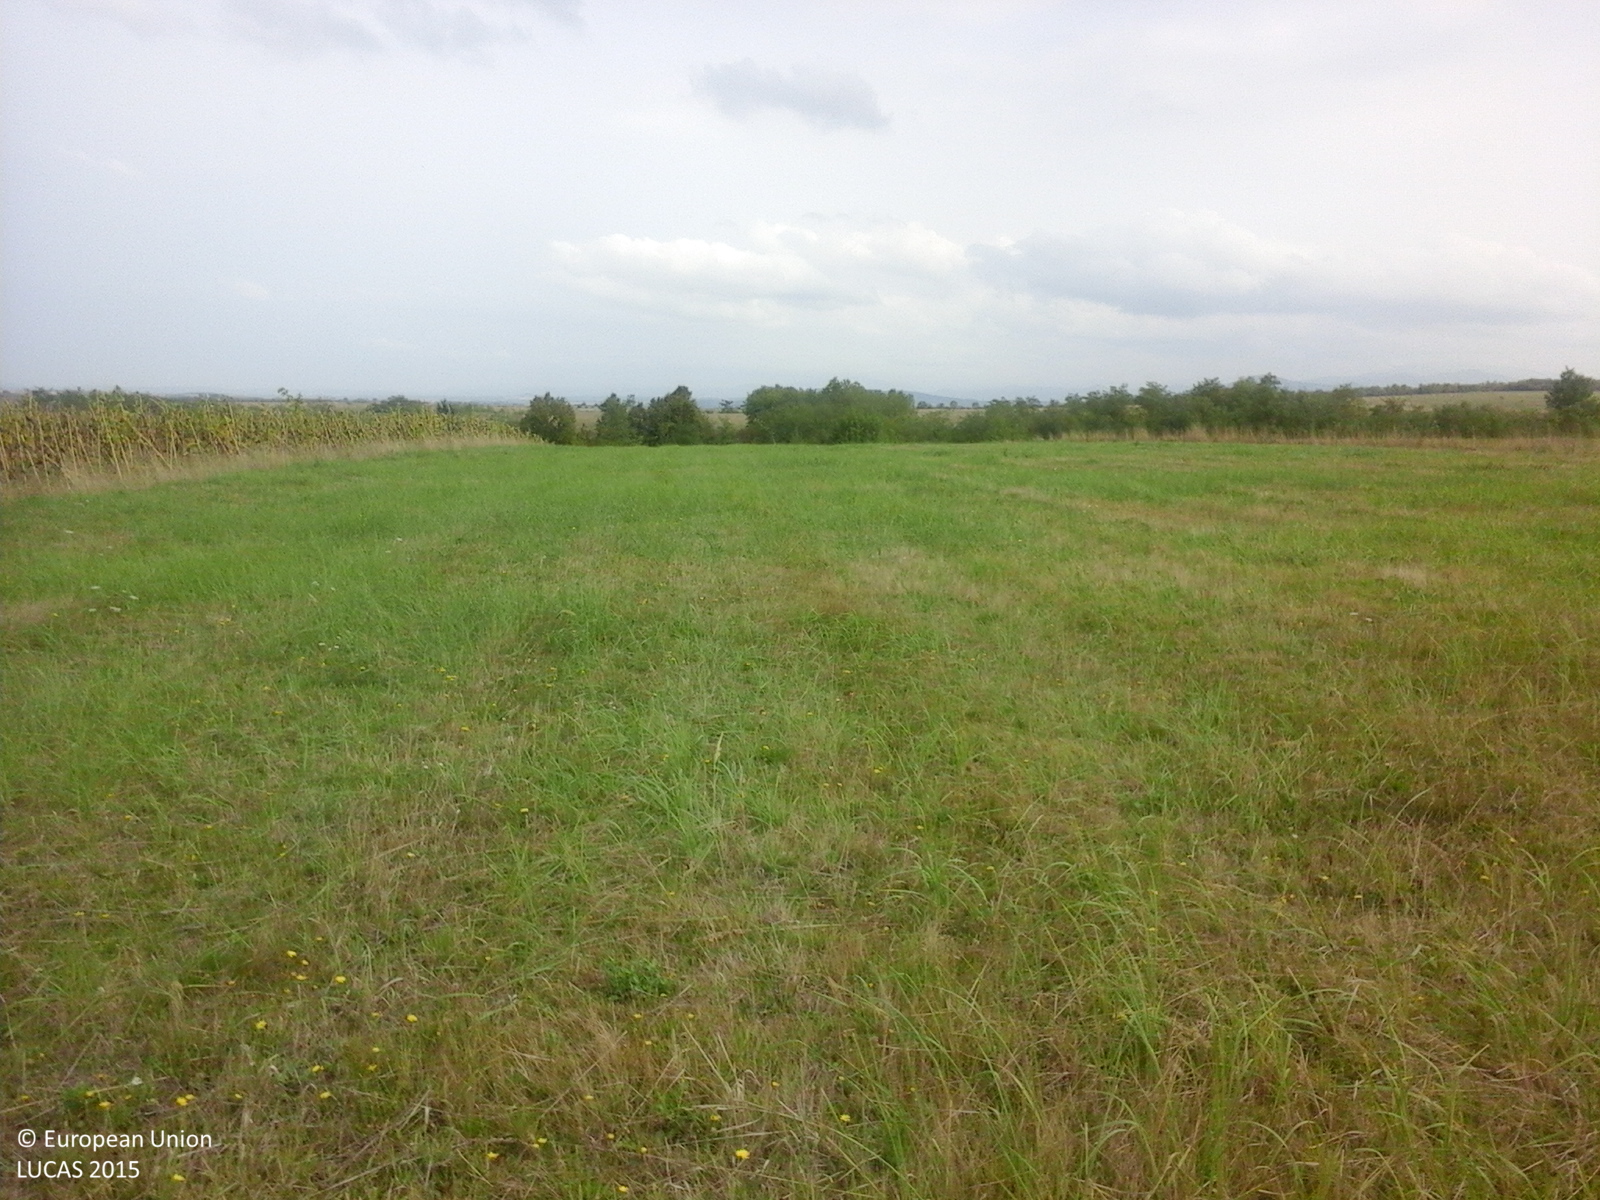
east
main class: Grassland
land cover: Grassland without tree/shrub cover
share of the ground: > 75 %
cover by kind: herbaceous plants 100 %
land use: Agriculture (excluding fallow land and kitchen gardens)
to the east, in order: Grassland without tree/shrub cover; Grassland with sparse tree/shrub cover; Broadleaved woodland; Grassland without tree/shrub cover
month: September
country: RO
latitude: 45.7862
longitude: 21.9638
